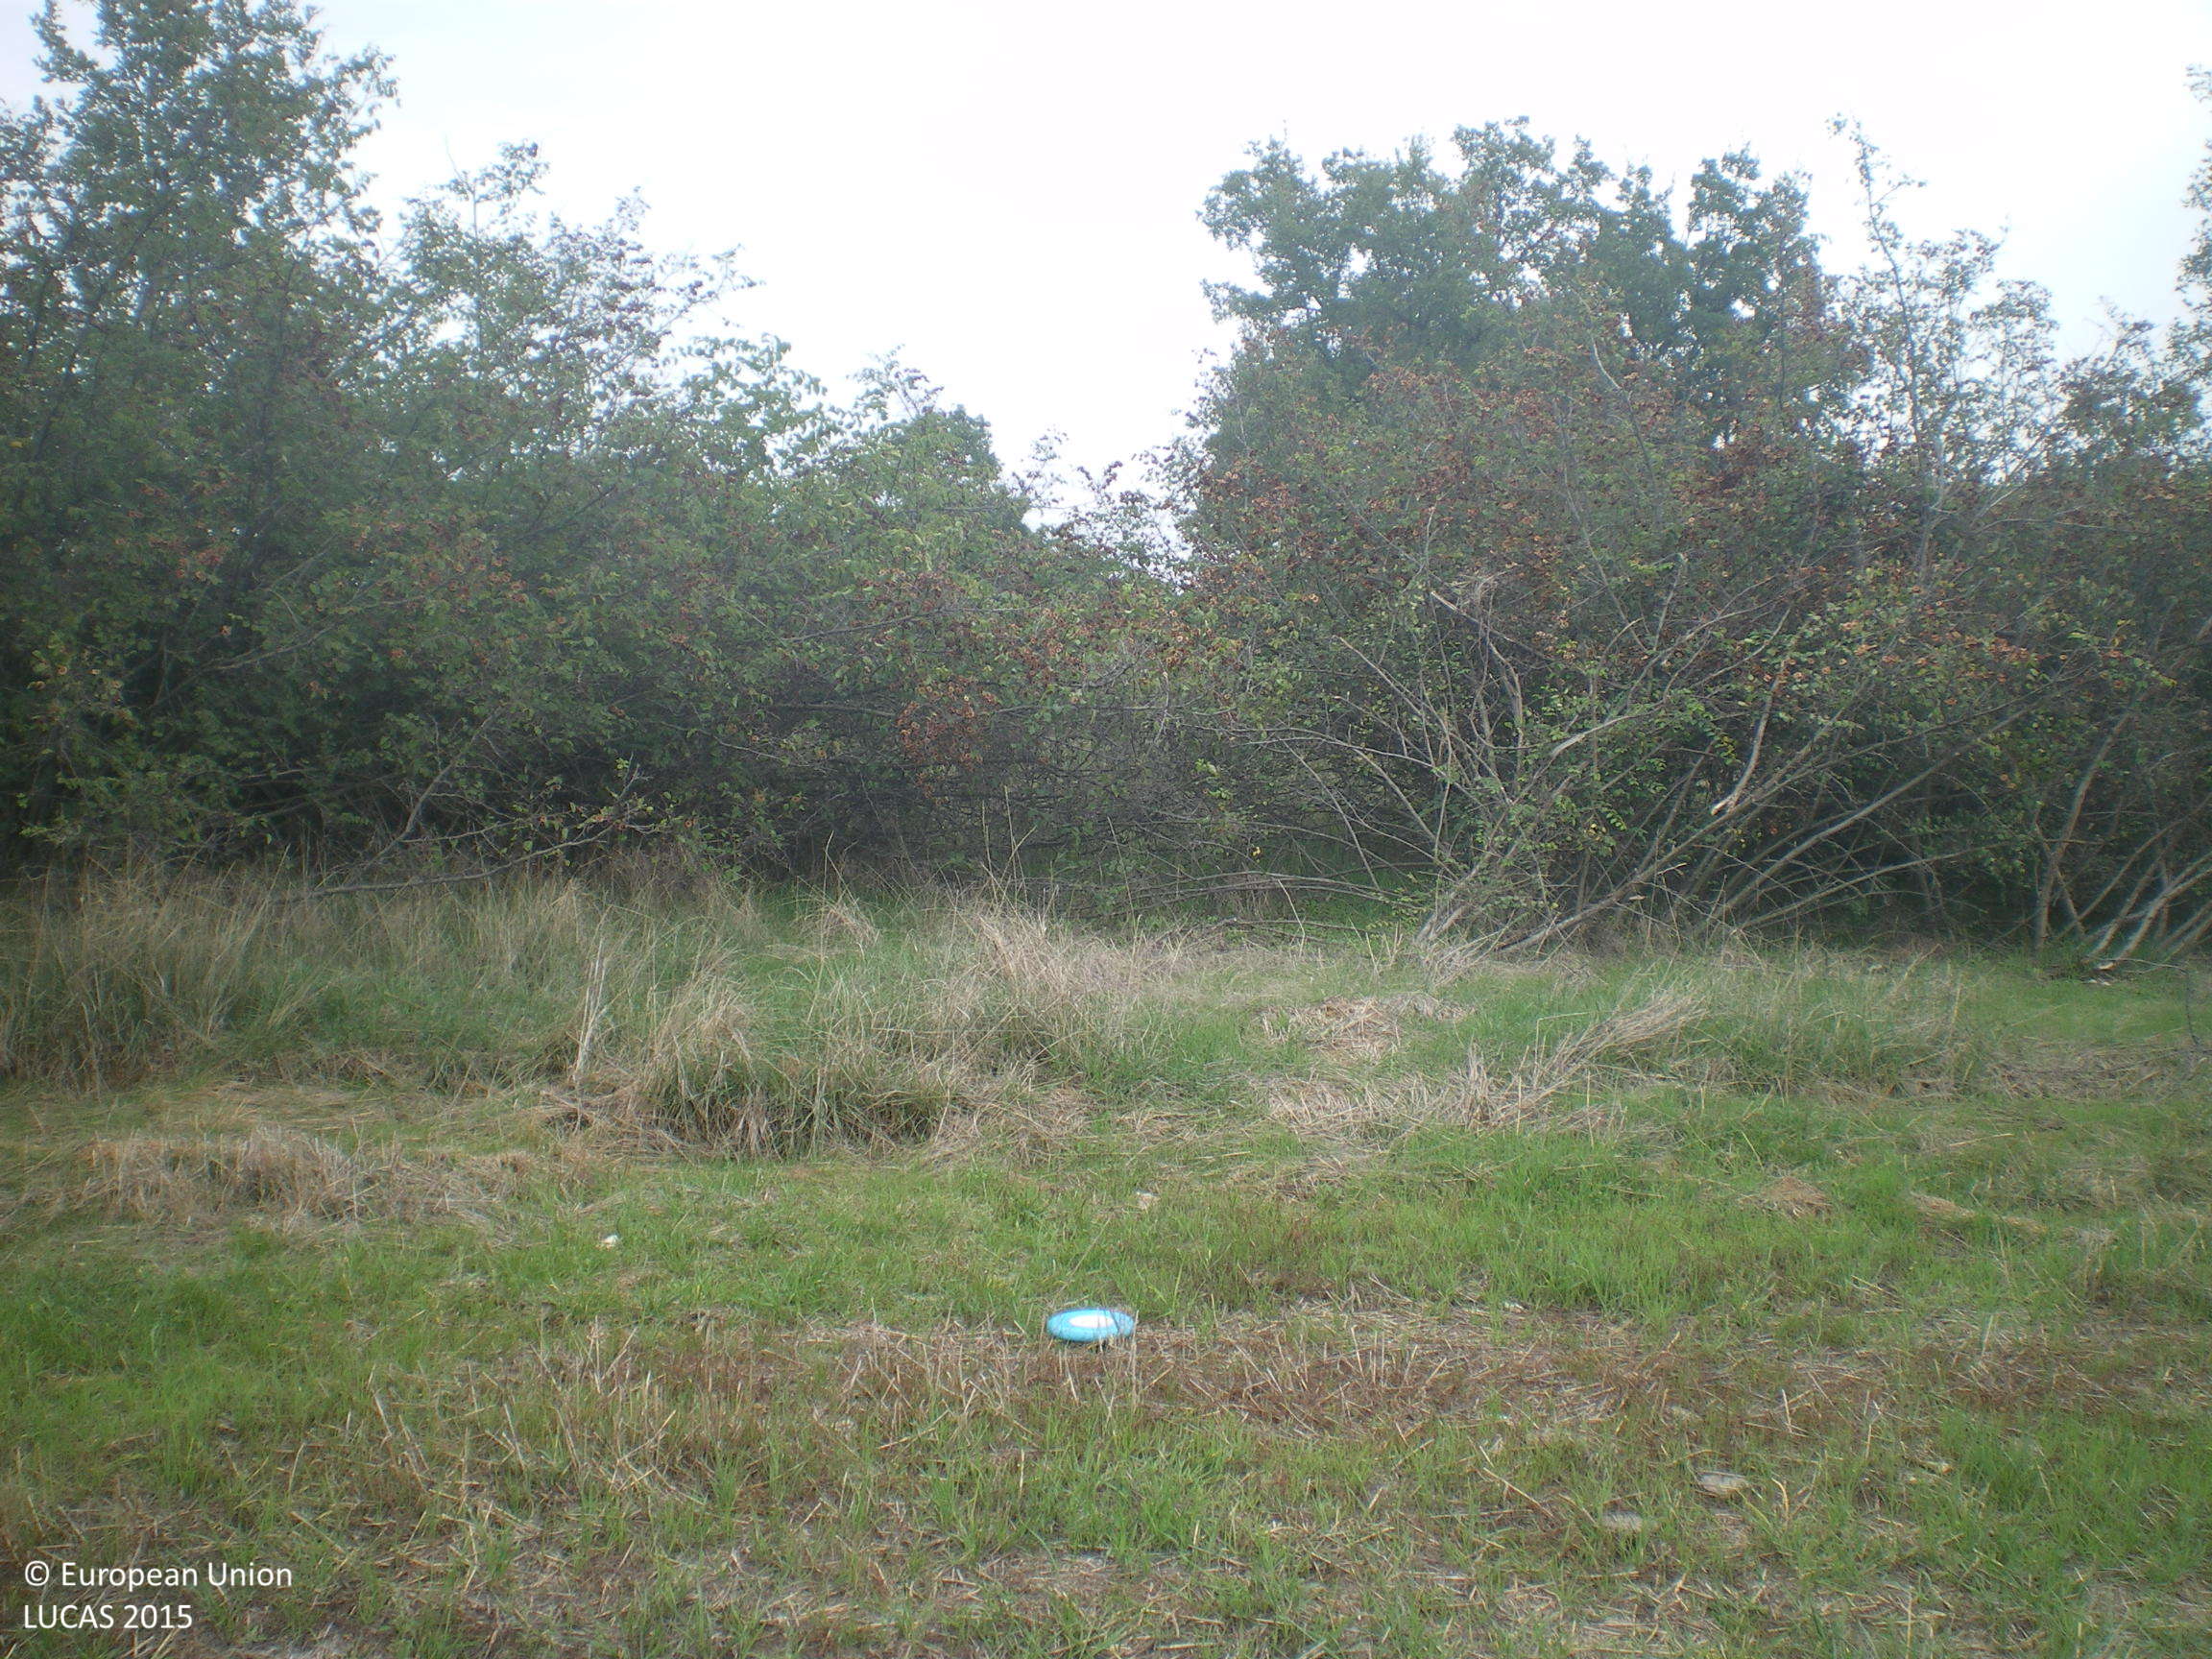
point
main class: Cropland
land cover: Common wheat
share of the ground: < 10 %
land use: Agriculture (excluding fallow land and kitchen gardens)
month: October
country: BG
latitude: 41.9295
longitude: 26.0782
